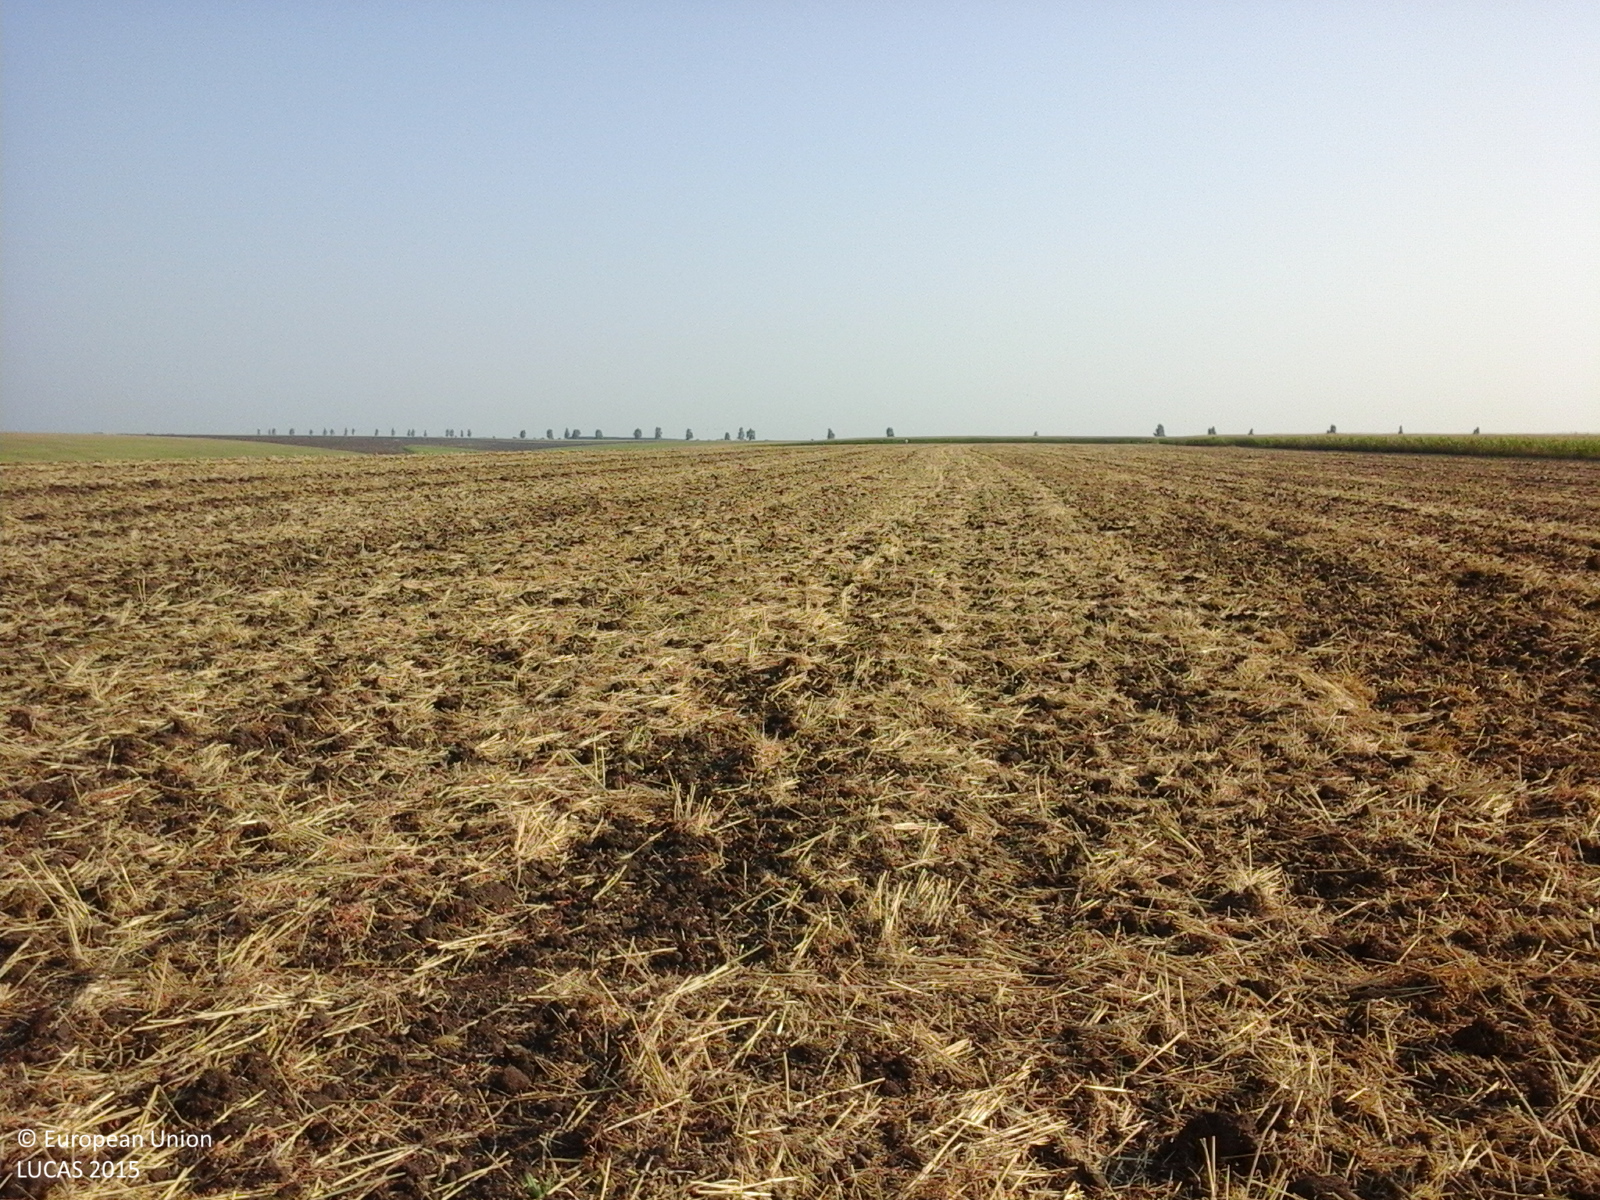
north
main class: Cropland
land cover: Common wheat
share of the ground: 25 - 50 %
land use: Agriculture (excluding fallow land and kitchen gardens)
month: July
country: RO
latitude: 45.6870
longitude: 27.9265
